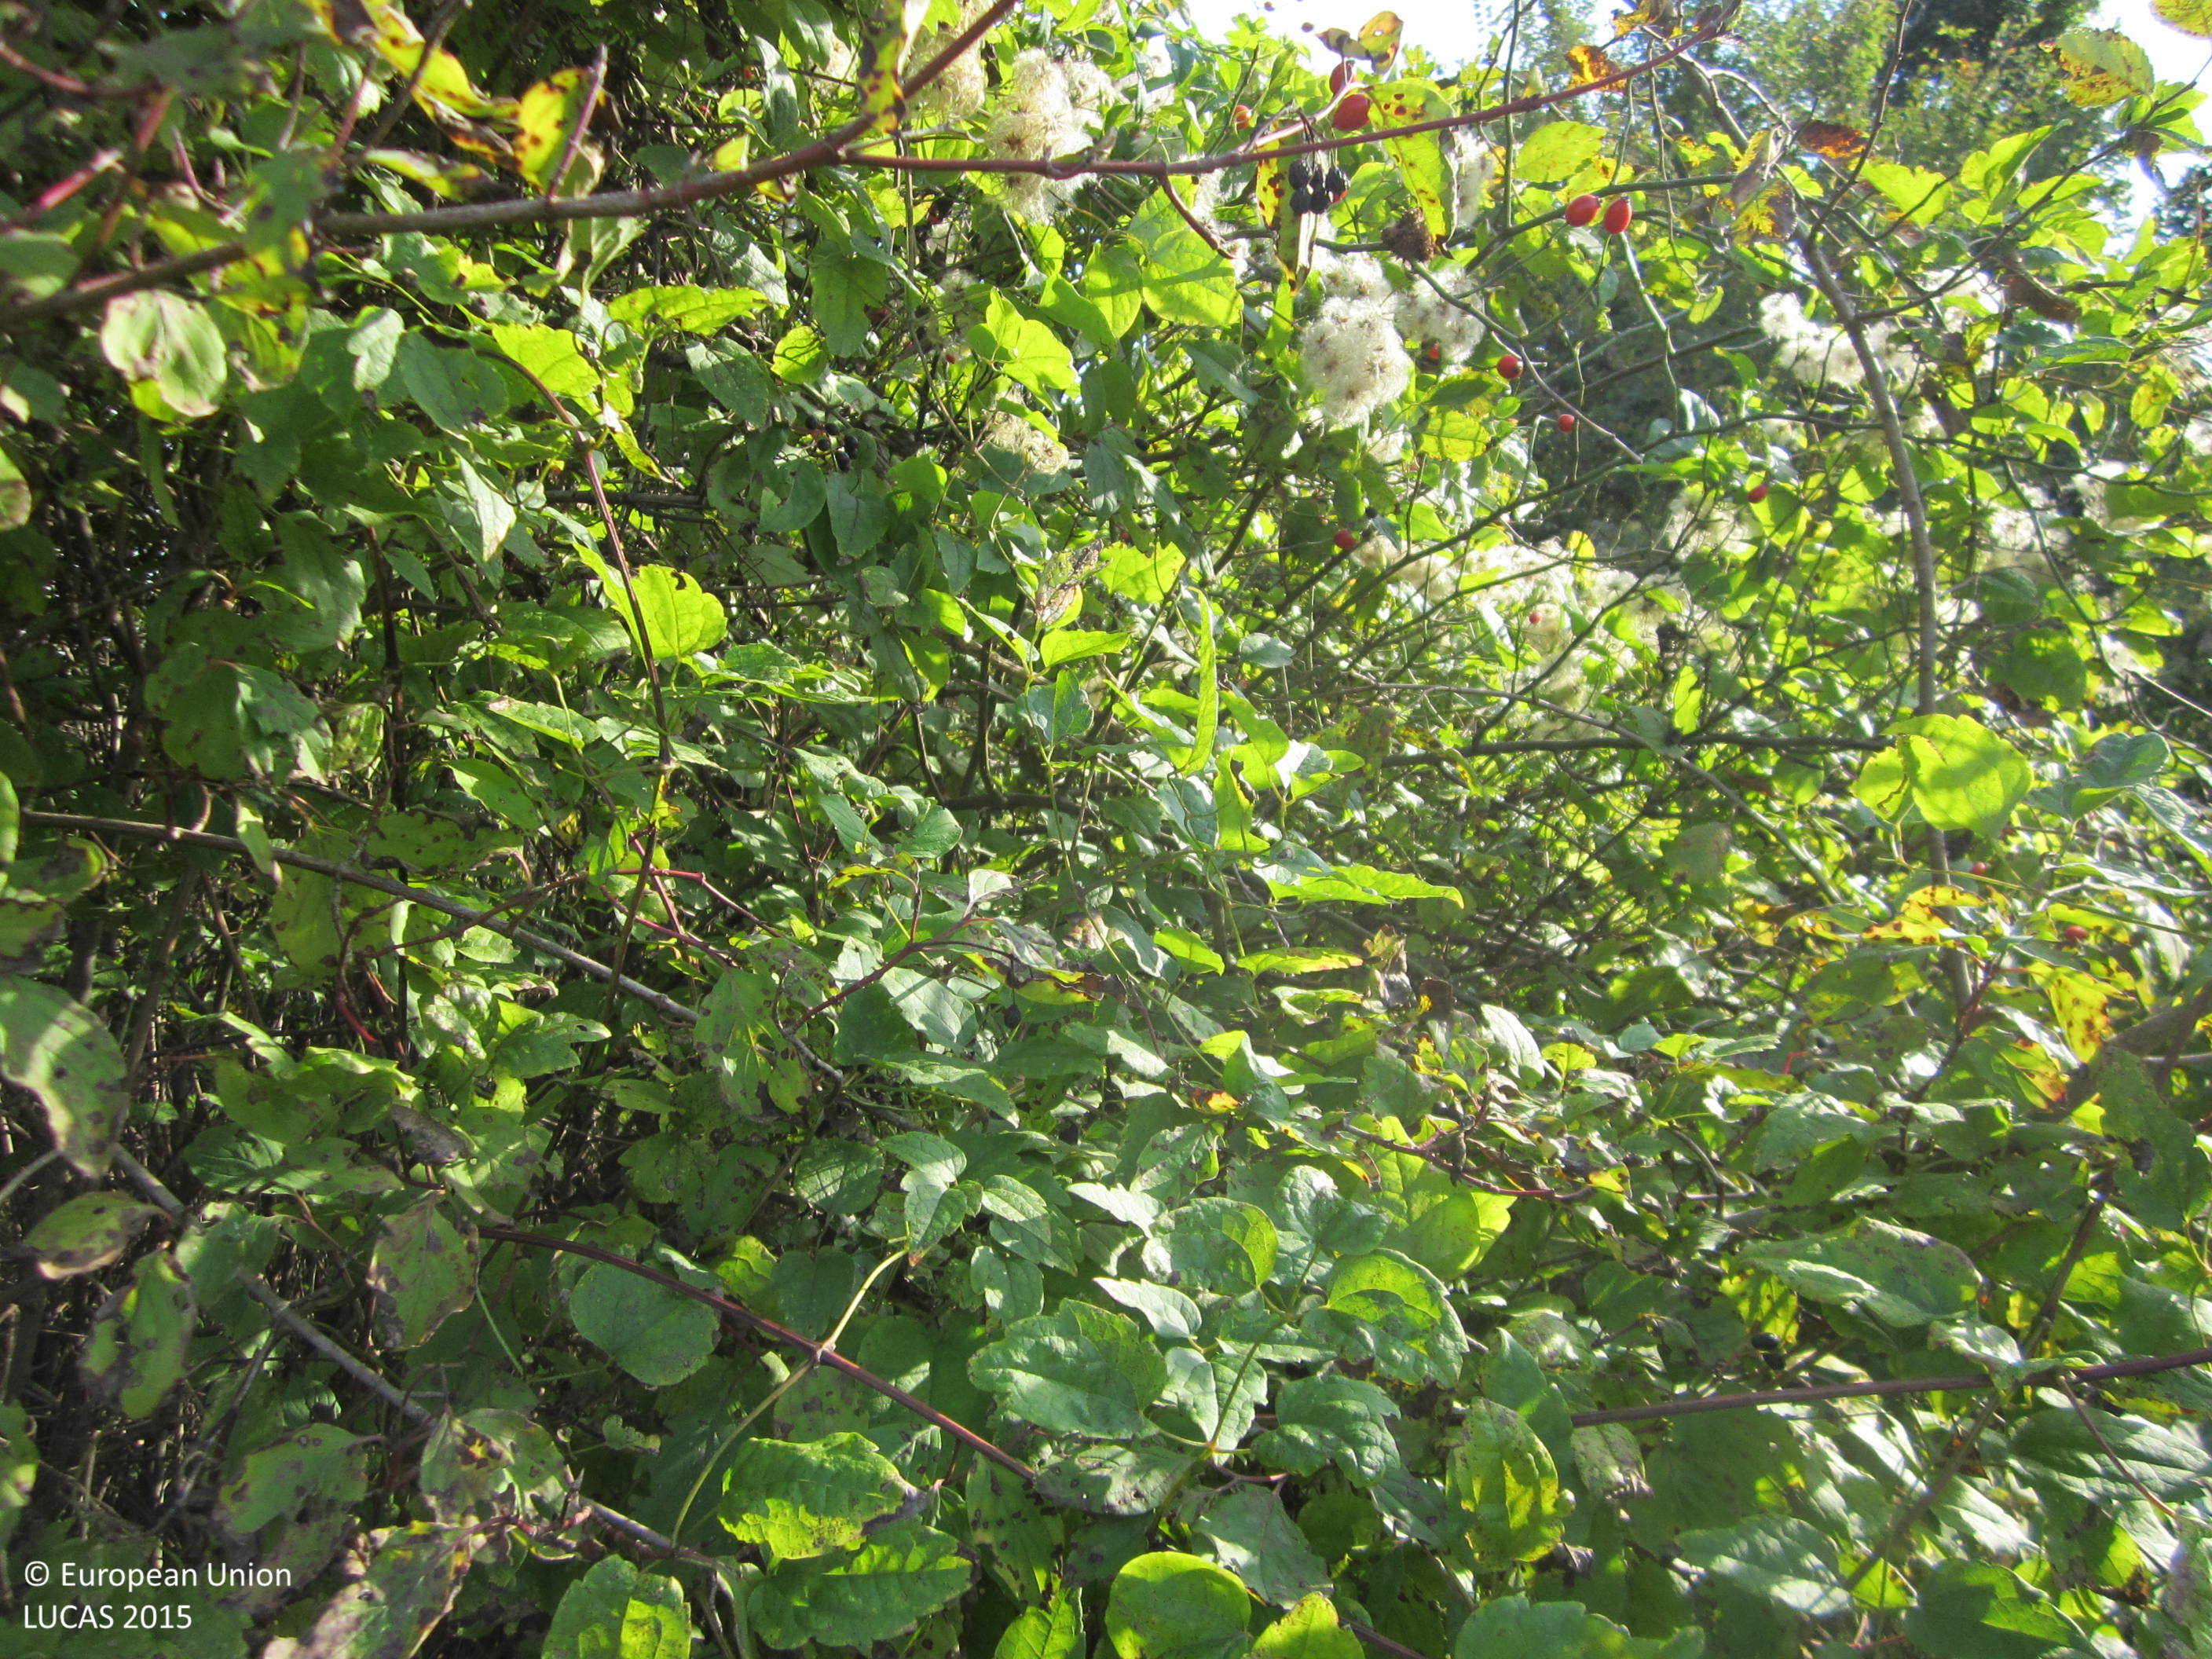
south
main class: Woodland
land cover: Broadleaved woodland
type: mesophytic deciduous forest
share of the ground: 25 - 50 %
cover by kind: herbaceous plants 40 %, broadleaved forest trees 30 %, shrubs 30 %
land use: Semi-natural and natural areas not in use
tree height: > 5 m
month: October
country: BG
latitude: 42.7340
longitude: 26.7744
